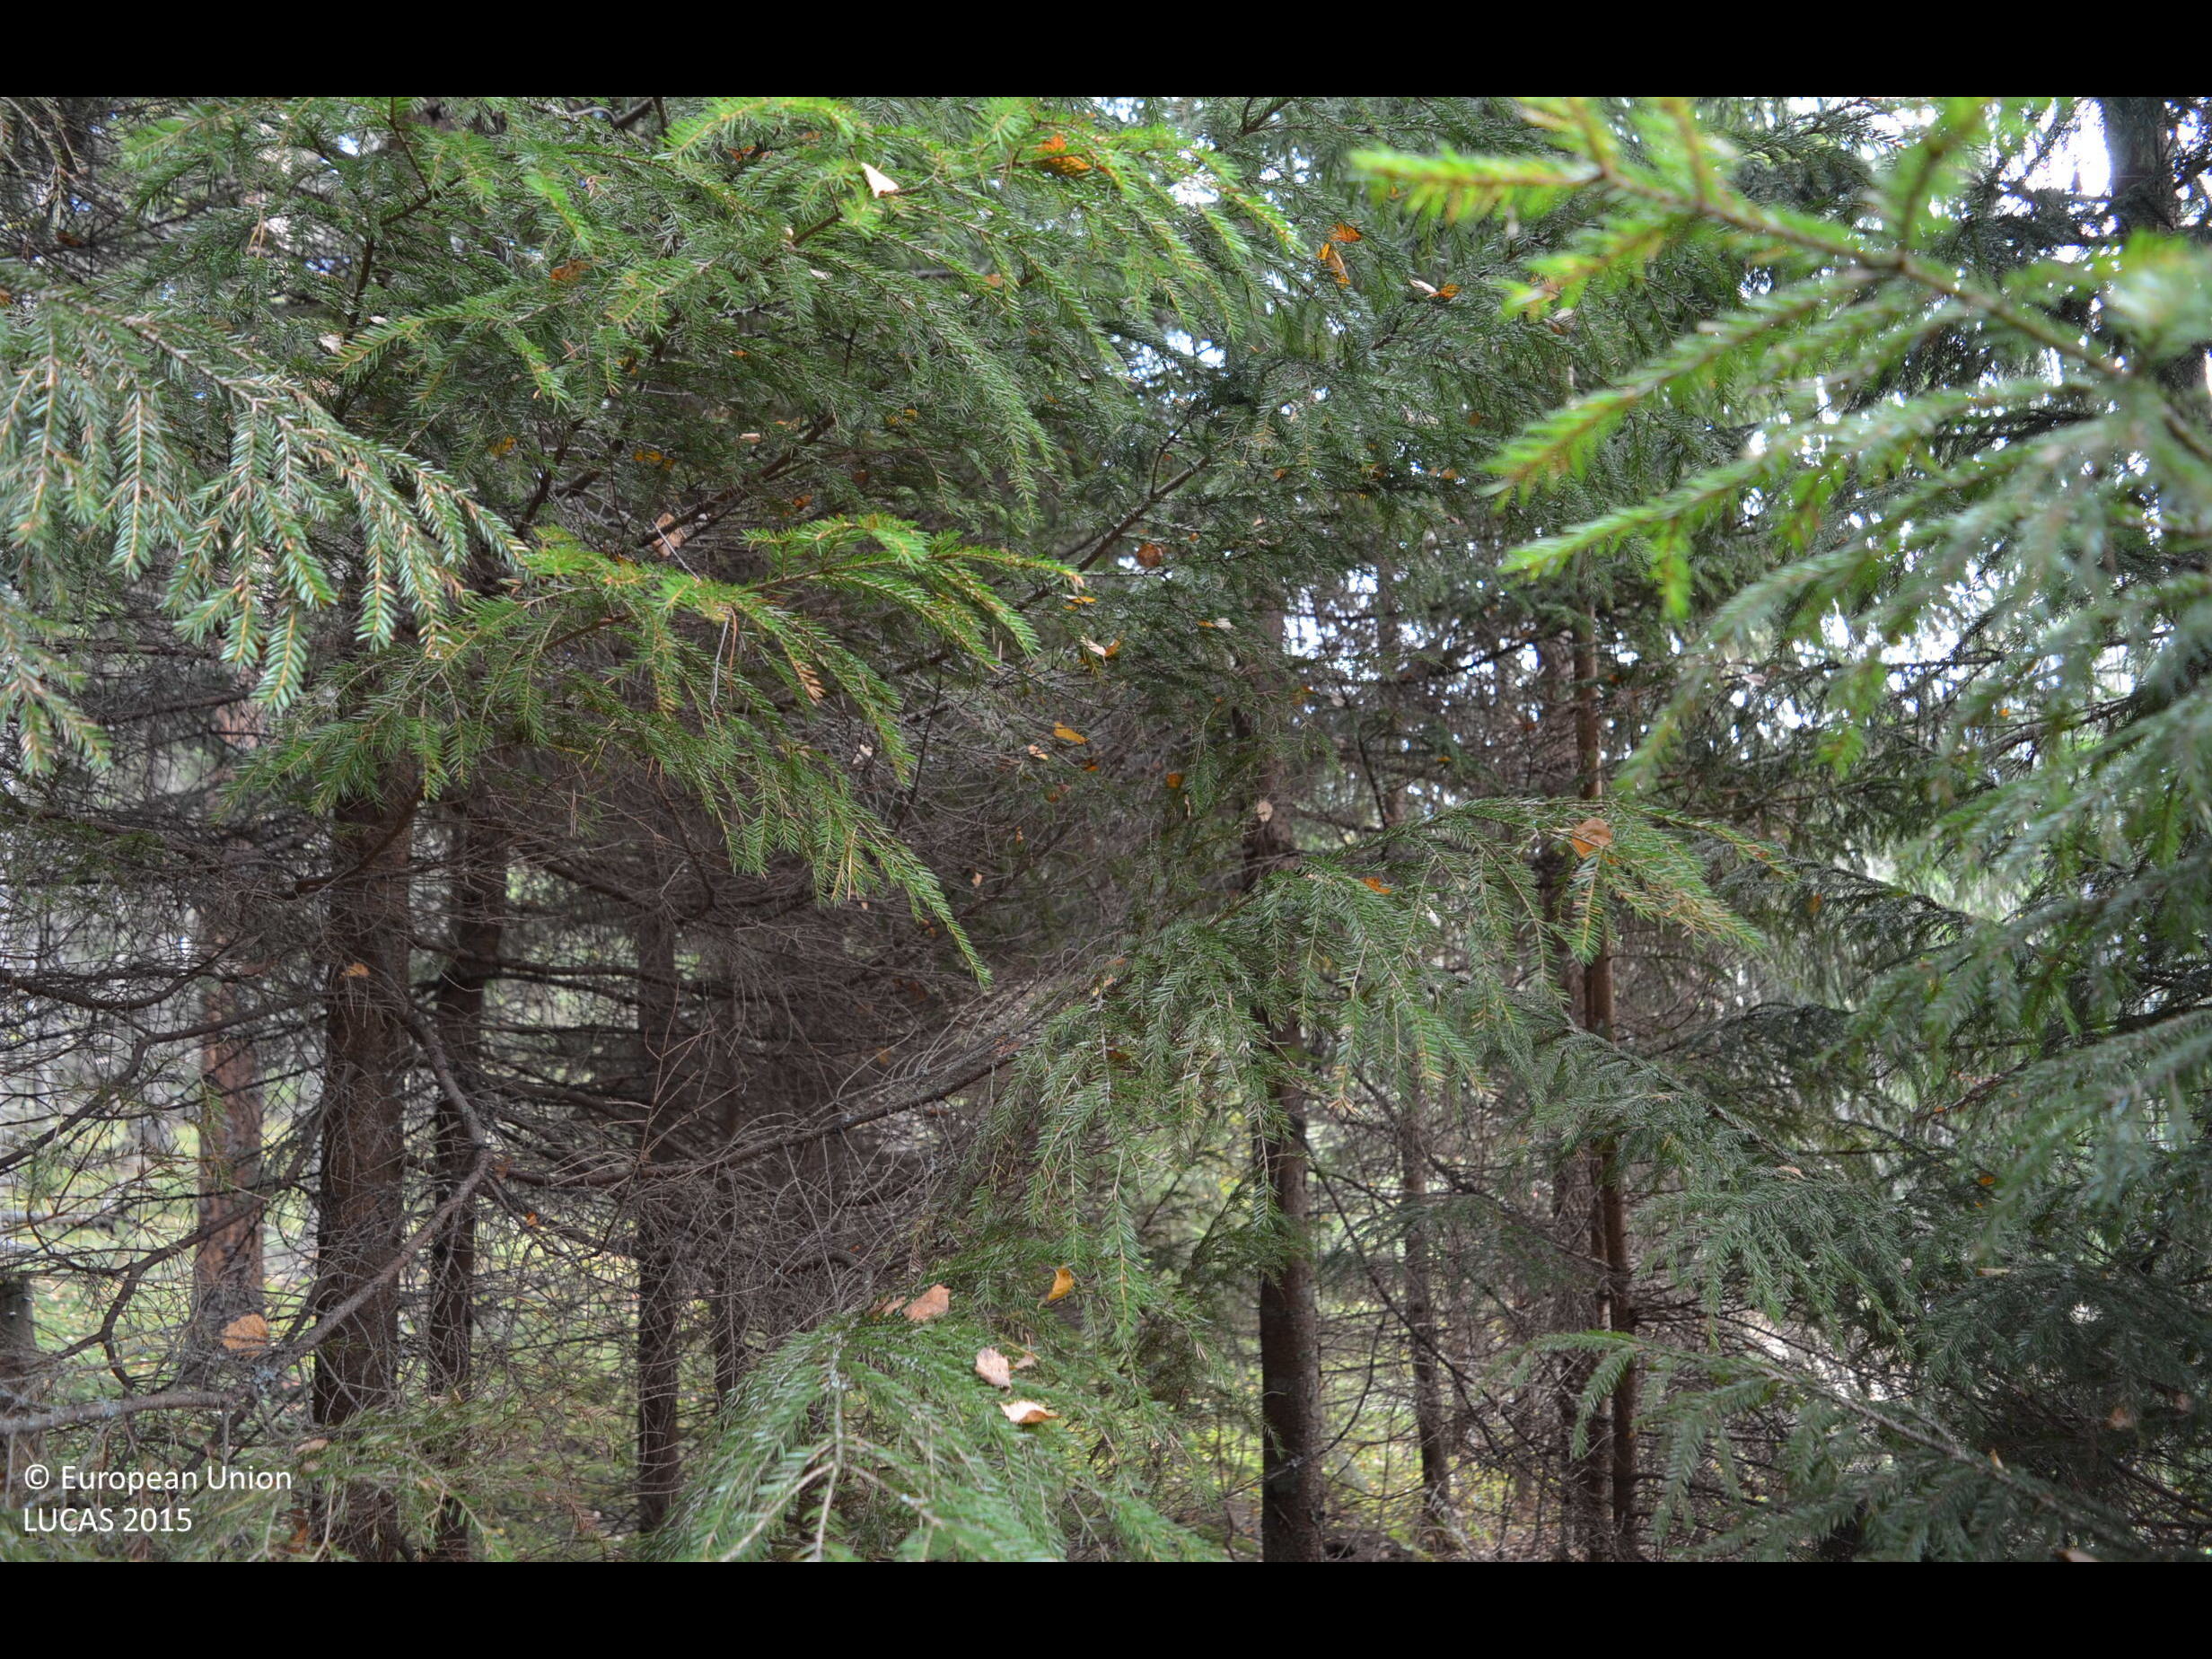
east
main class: Woodland
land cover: Spruce dominated mixed woodland
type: boreal forest
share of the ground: > 75 %
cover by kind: coniferous forest trees 55 %, broadleaved forest trees 20 %, shrubs 10 %, lichens and mosses 10 %, herbaceous plants 5 %
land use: Forestry
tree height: > 5 m
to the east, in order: Spruce dominated mixed woodland; Lichens and moss; Spruce dominated mixed woodland; Other mixed woodland; Spruce dominated mixed woodland
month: October
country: FI
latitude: 61.4643
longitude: 23.1531
